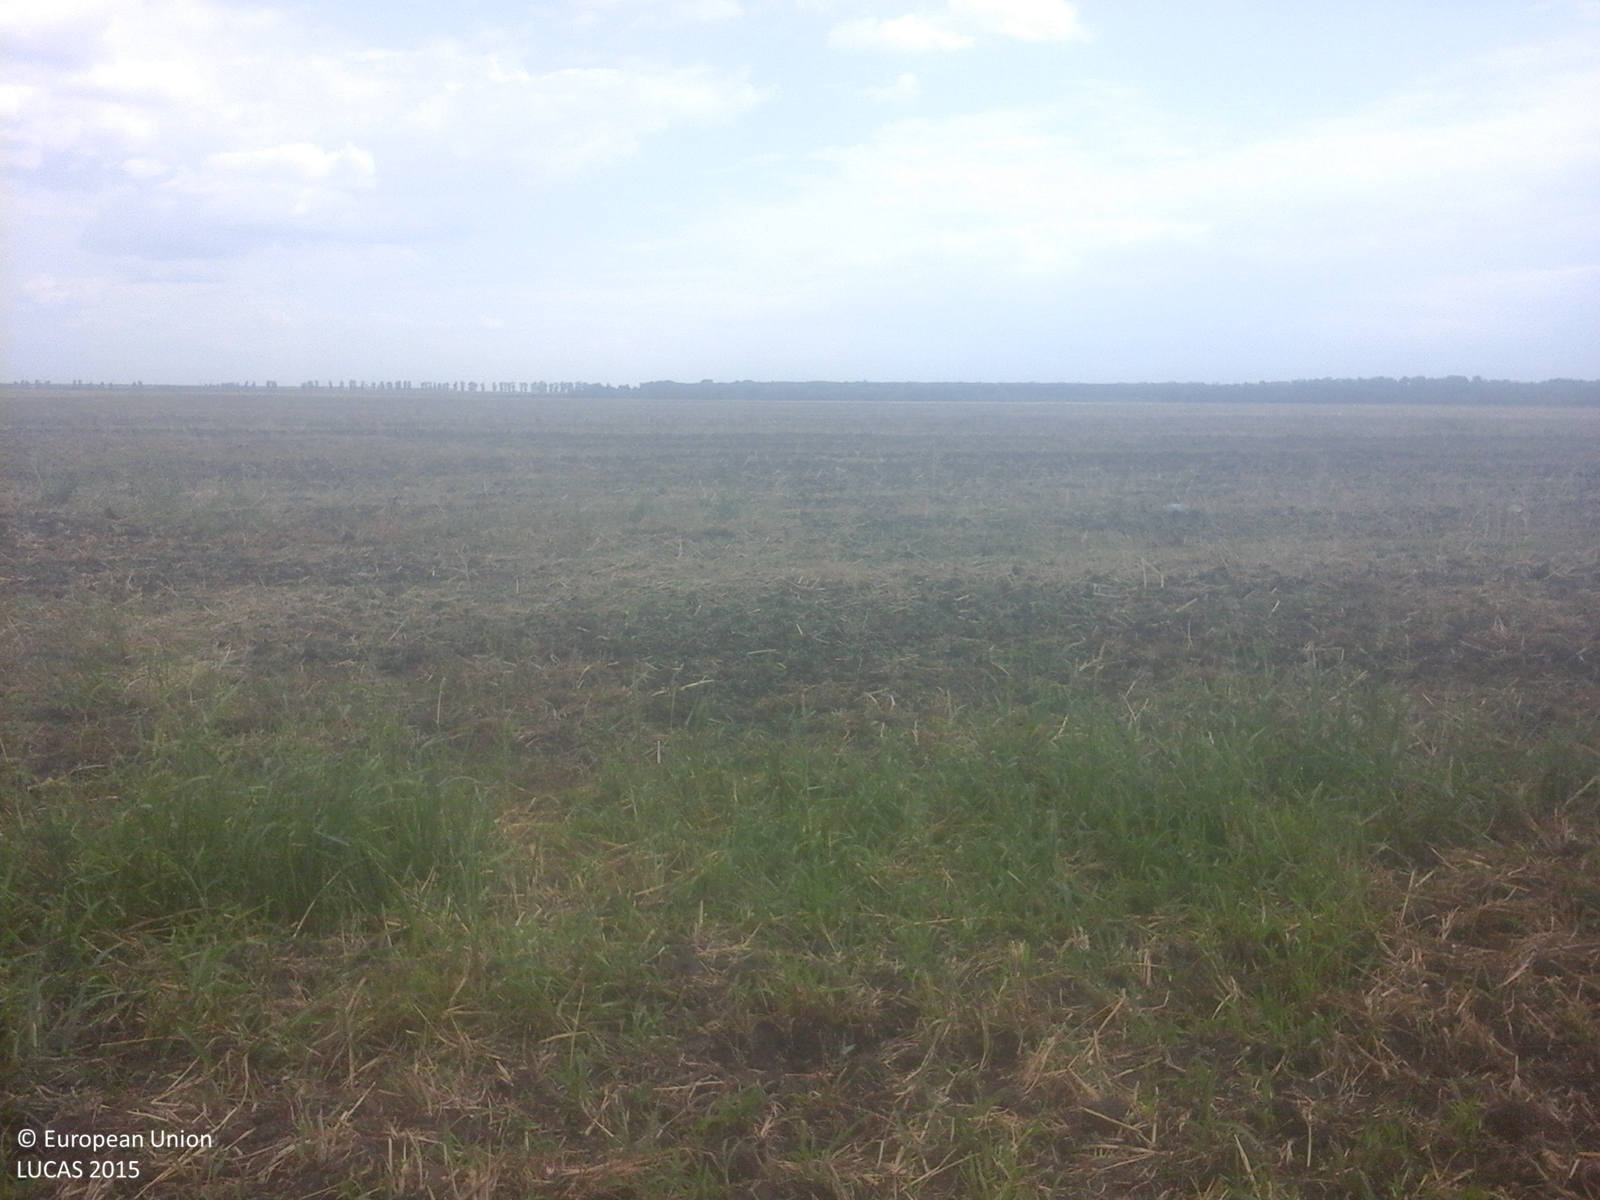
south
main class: Cropland
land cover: Rape and turnip rape
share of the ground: < 10 %
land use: Agriculture (excluding fallow land and kitchen gardens)
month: July
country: RO
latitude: 44.1238
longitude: 25.5478
